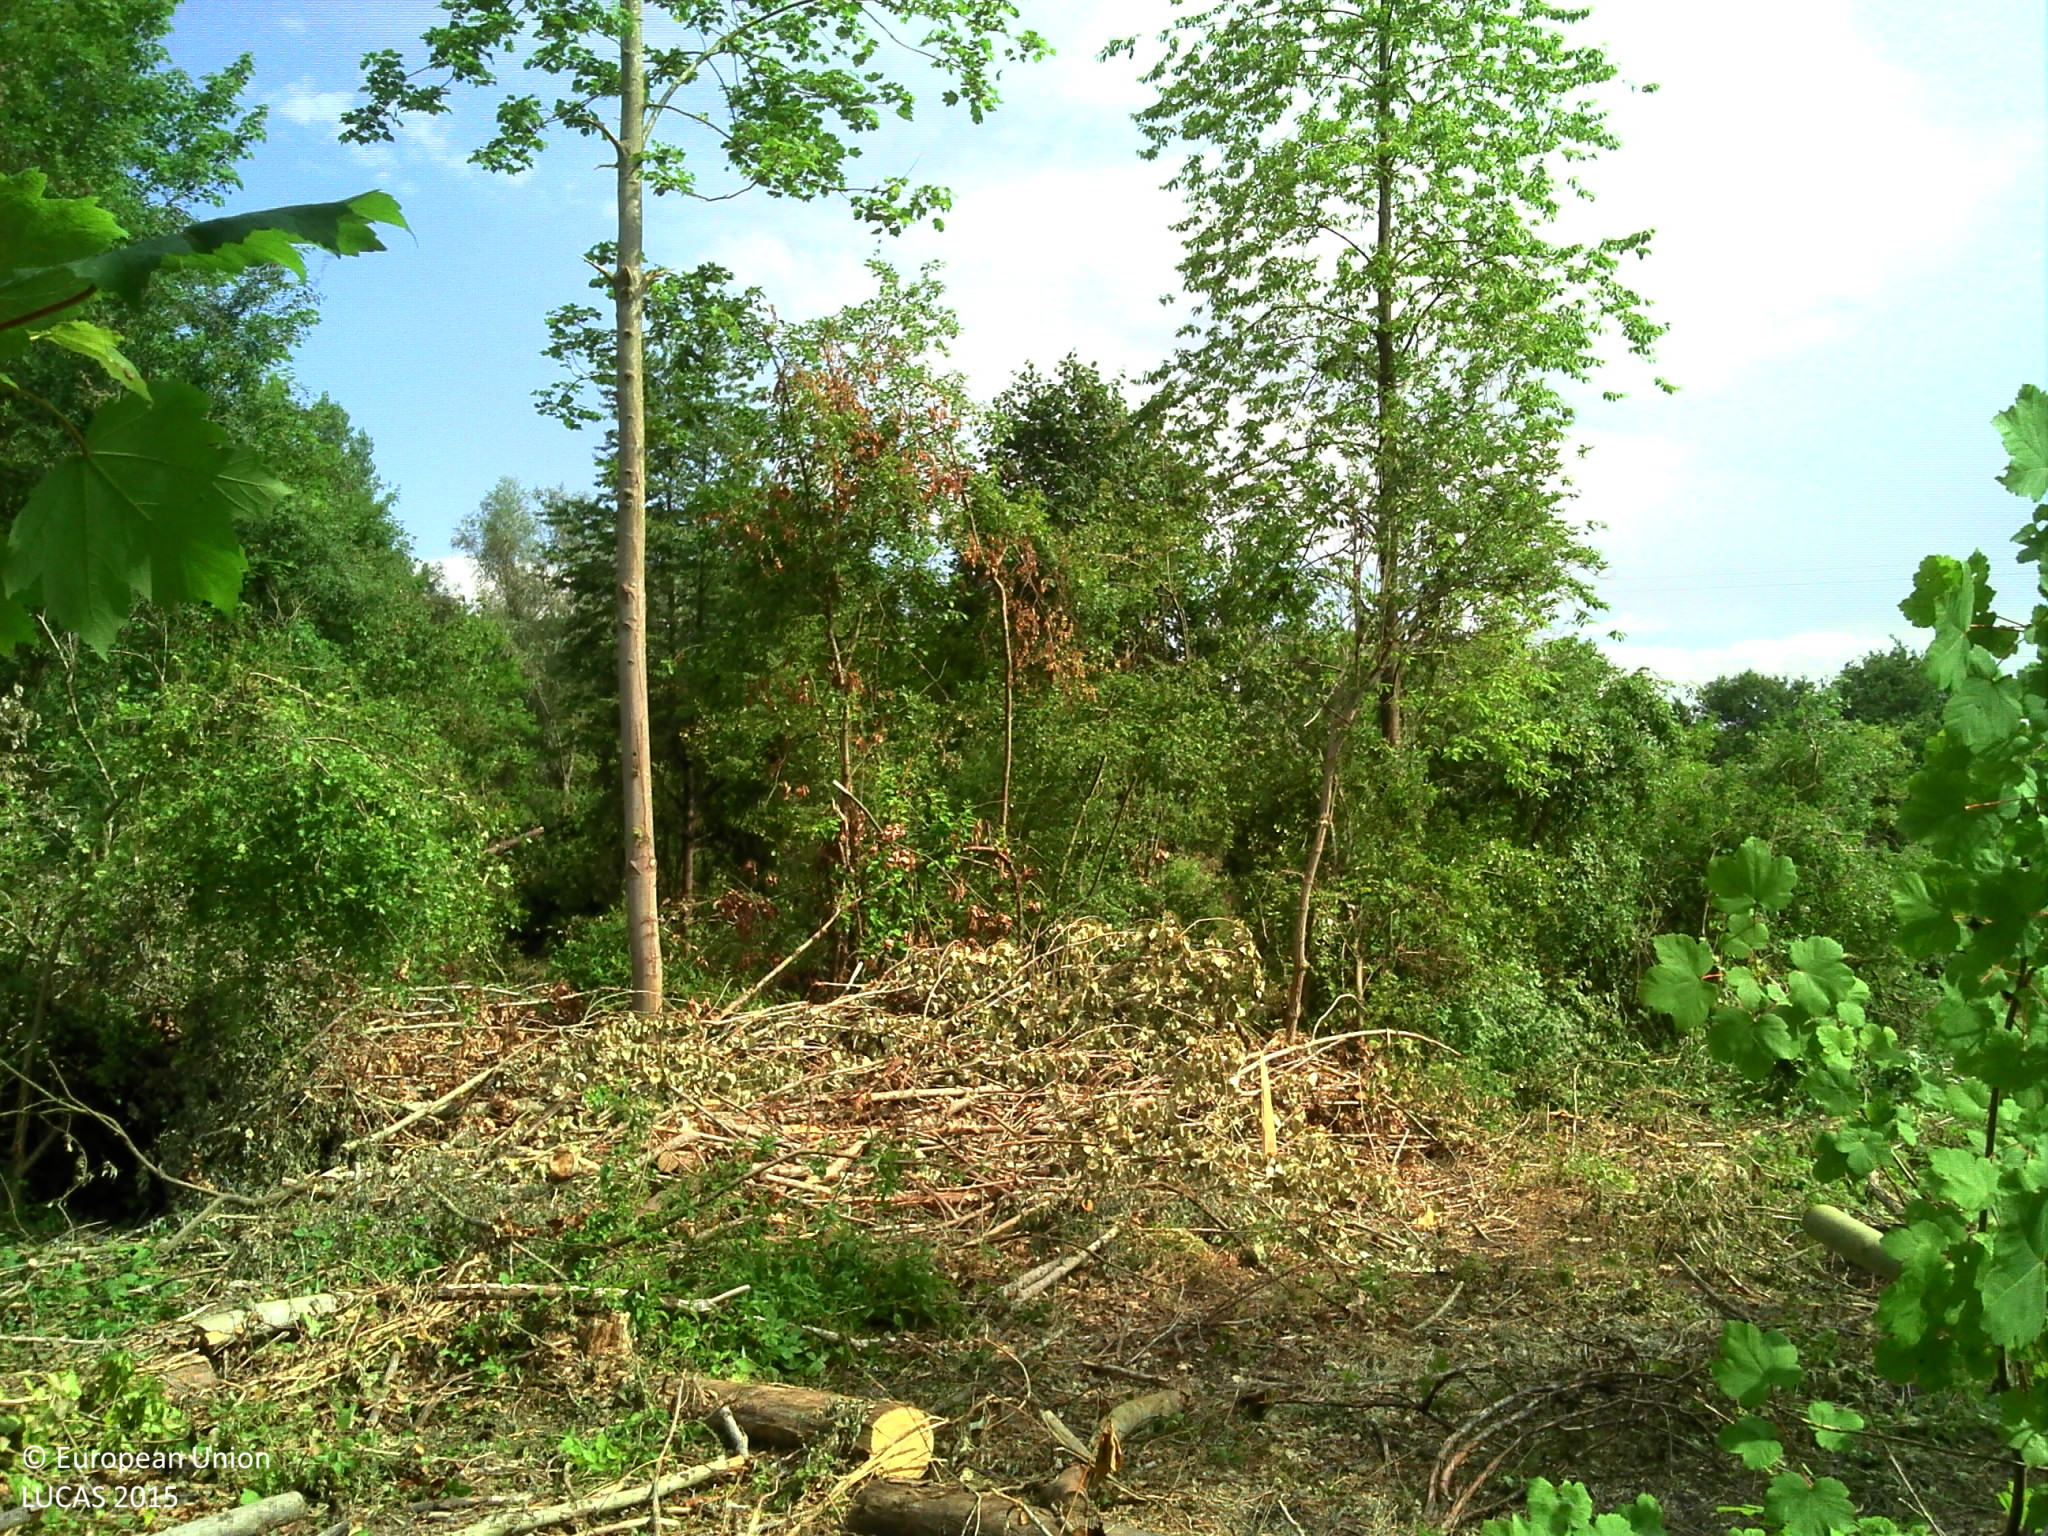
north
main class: Woodland
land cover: Broadleaved woodland
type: mesophytic deciduous forest
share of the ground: > 75 %
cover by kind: broadleaved forest trees 35 %, herbaceous plants 35 %, shrubs 30 %
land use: Forestry
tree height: > 5 m
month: July
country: FR
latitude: 49.3025
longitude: 2.4653
